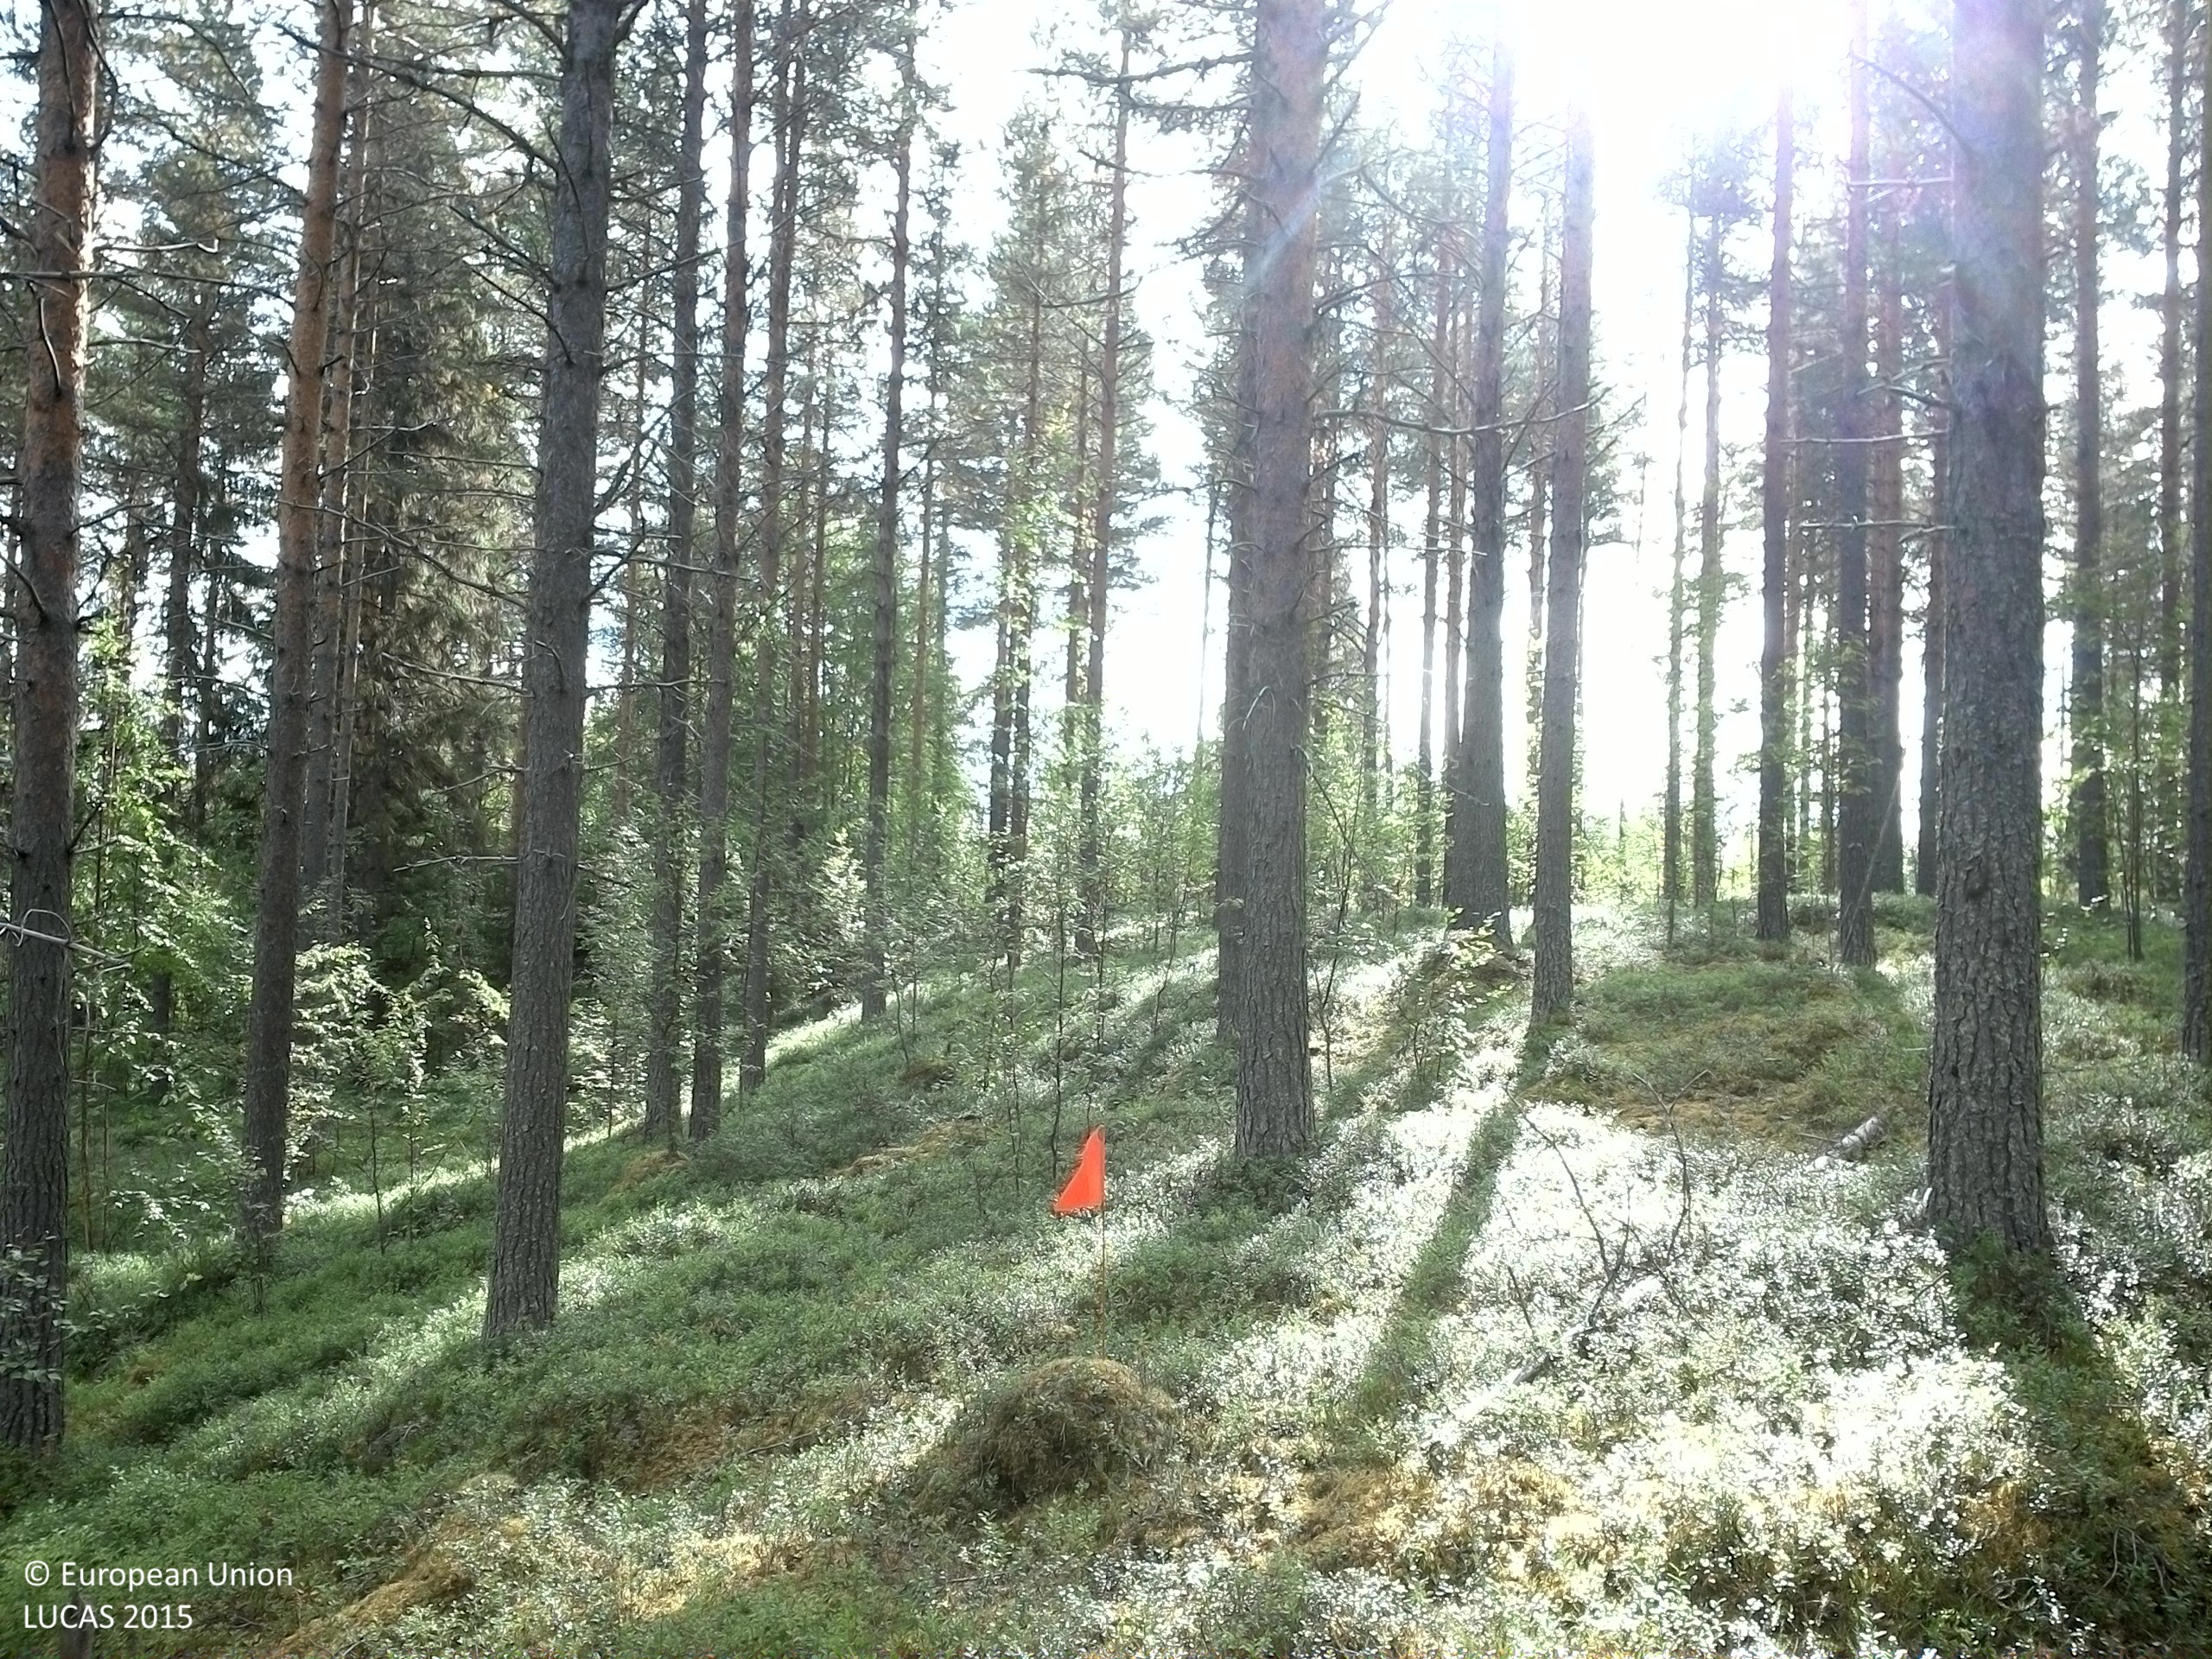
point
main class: Woodland
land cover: Pine dominated coniferous woodland
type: boreal forest
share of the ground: 50 - 75 %
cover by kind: coniferous forest trees 60 %, shrubs 25 %, lichens and mosses 10 %, broadleaved forest trees 5 %
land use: Forestry
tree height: > 5 m
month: September
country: SE
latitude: 64.1533
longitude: 17.3912
